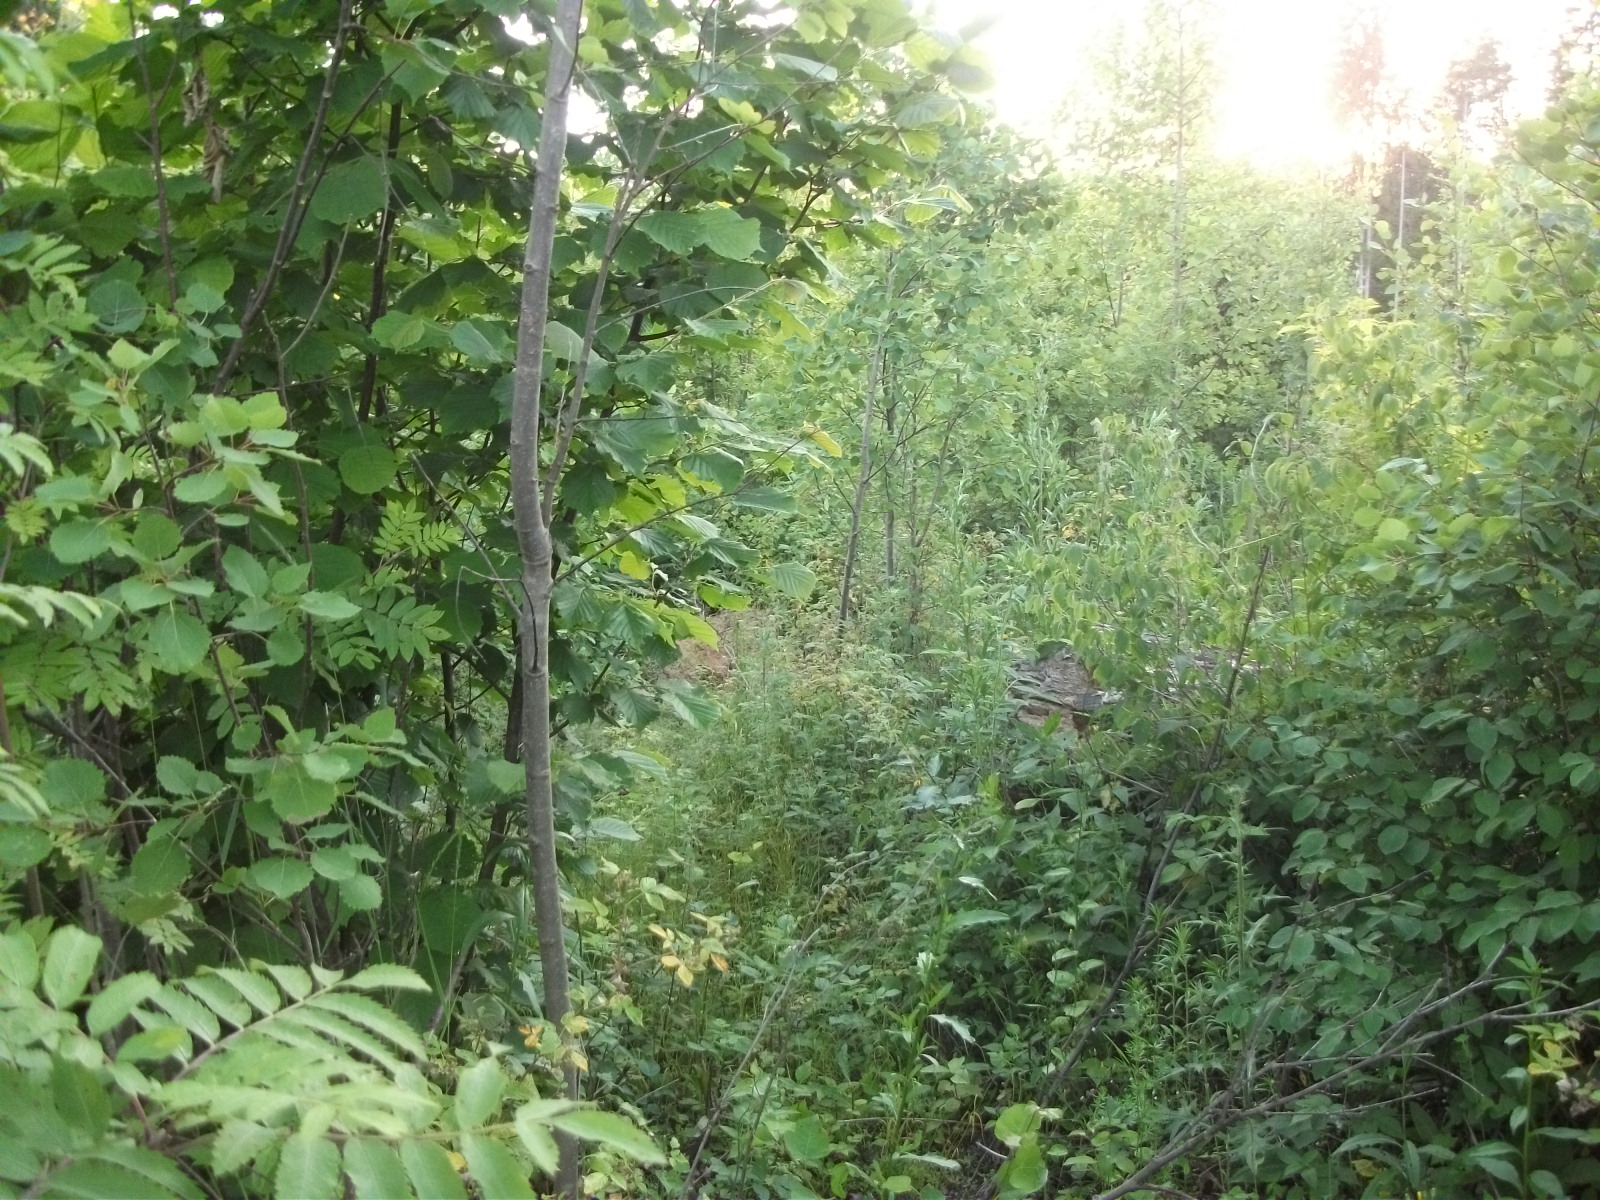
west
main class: Woodland
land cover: Broadleaved woodland
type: non-riverine alder, birch or aspen forest
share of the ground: > 75 %
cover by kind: broadleaved forest trees 80 %, shrubs 10 %, herbaceous plants 10 %
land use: Forestry
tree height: < 5 m
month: July
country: LV
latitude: 56.8377
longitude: 26.2179
